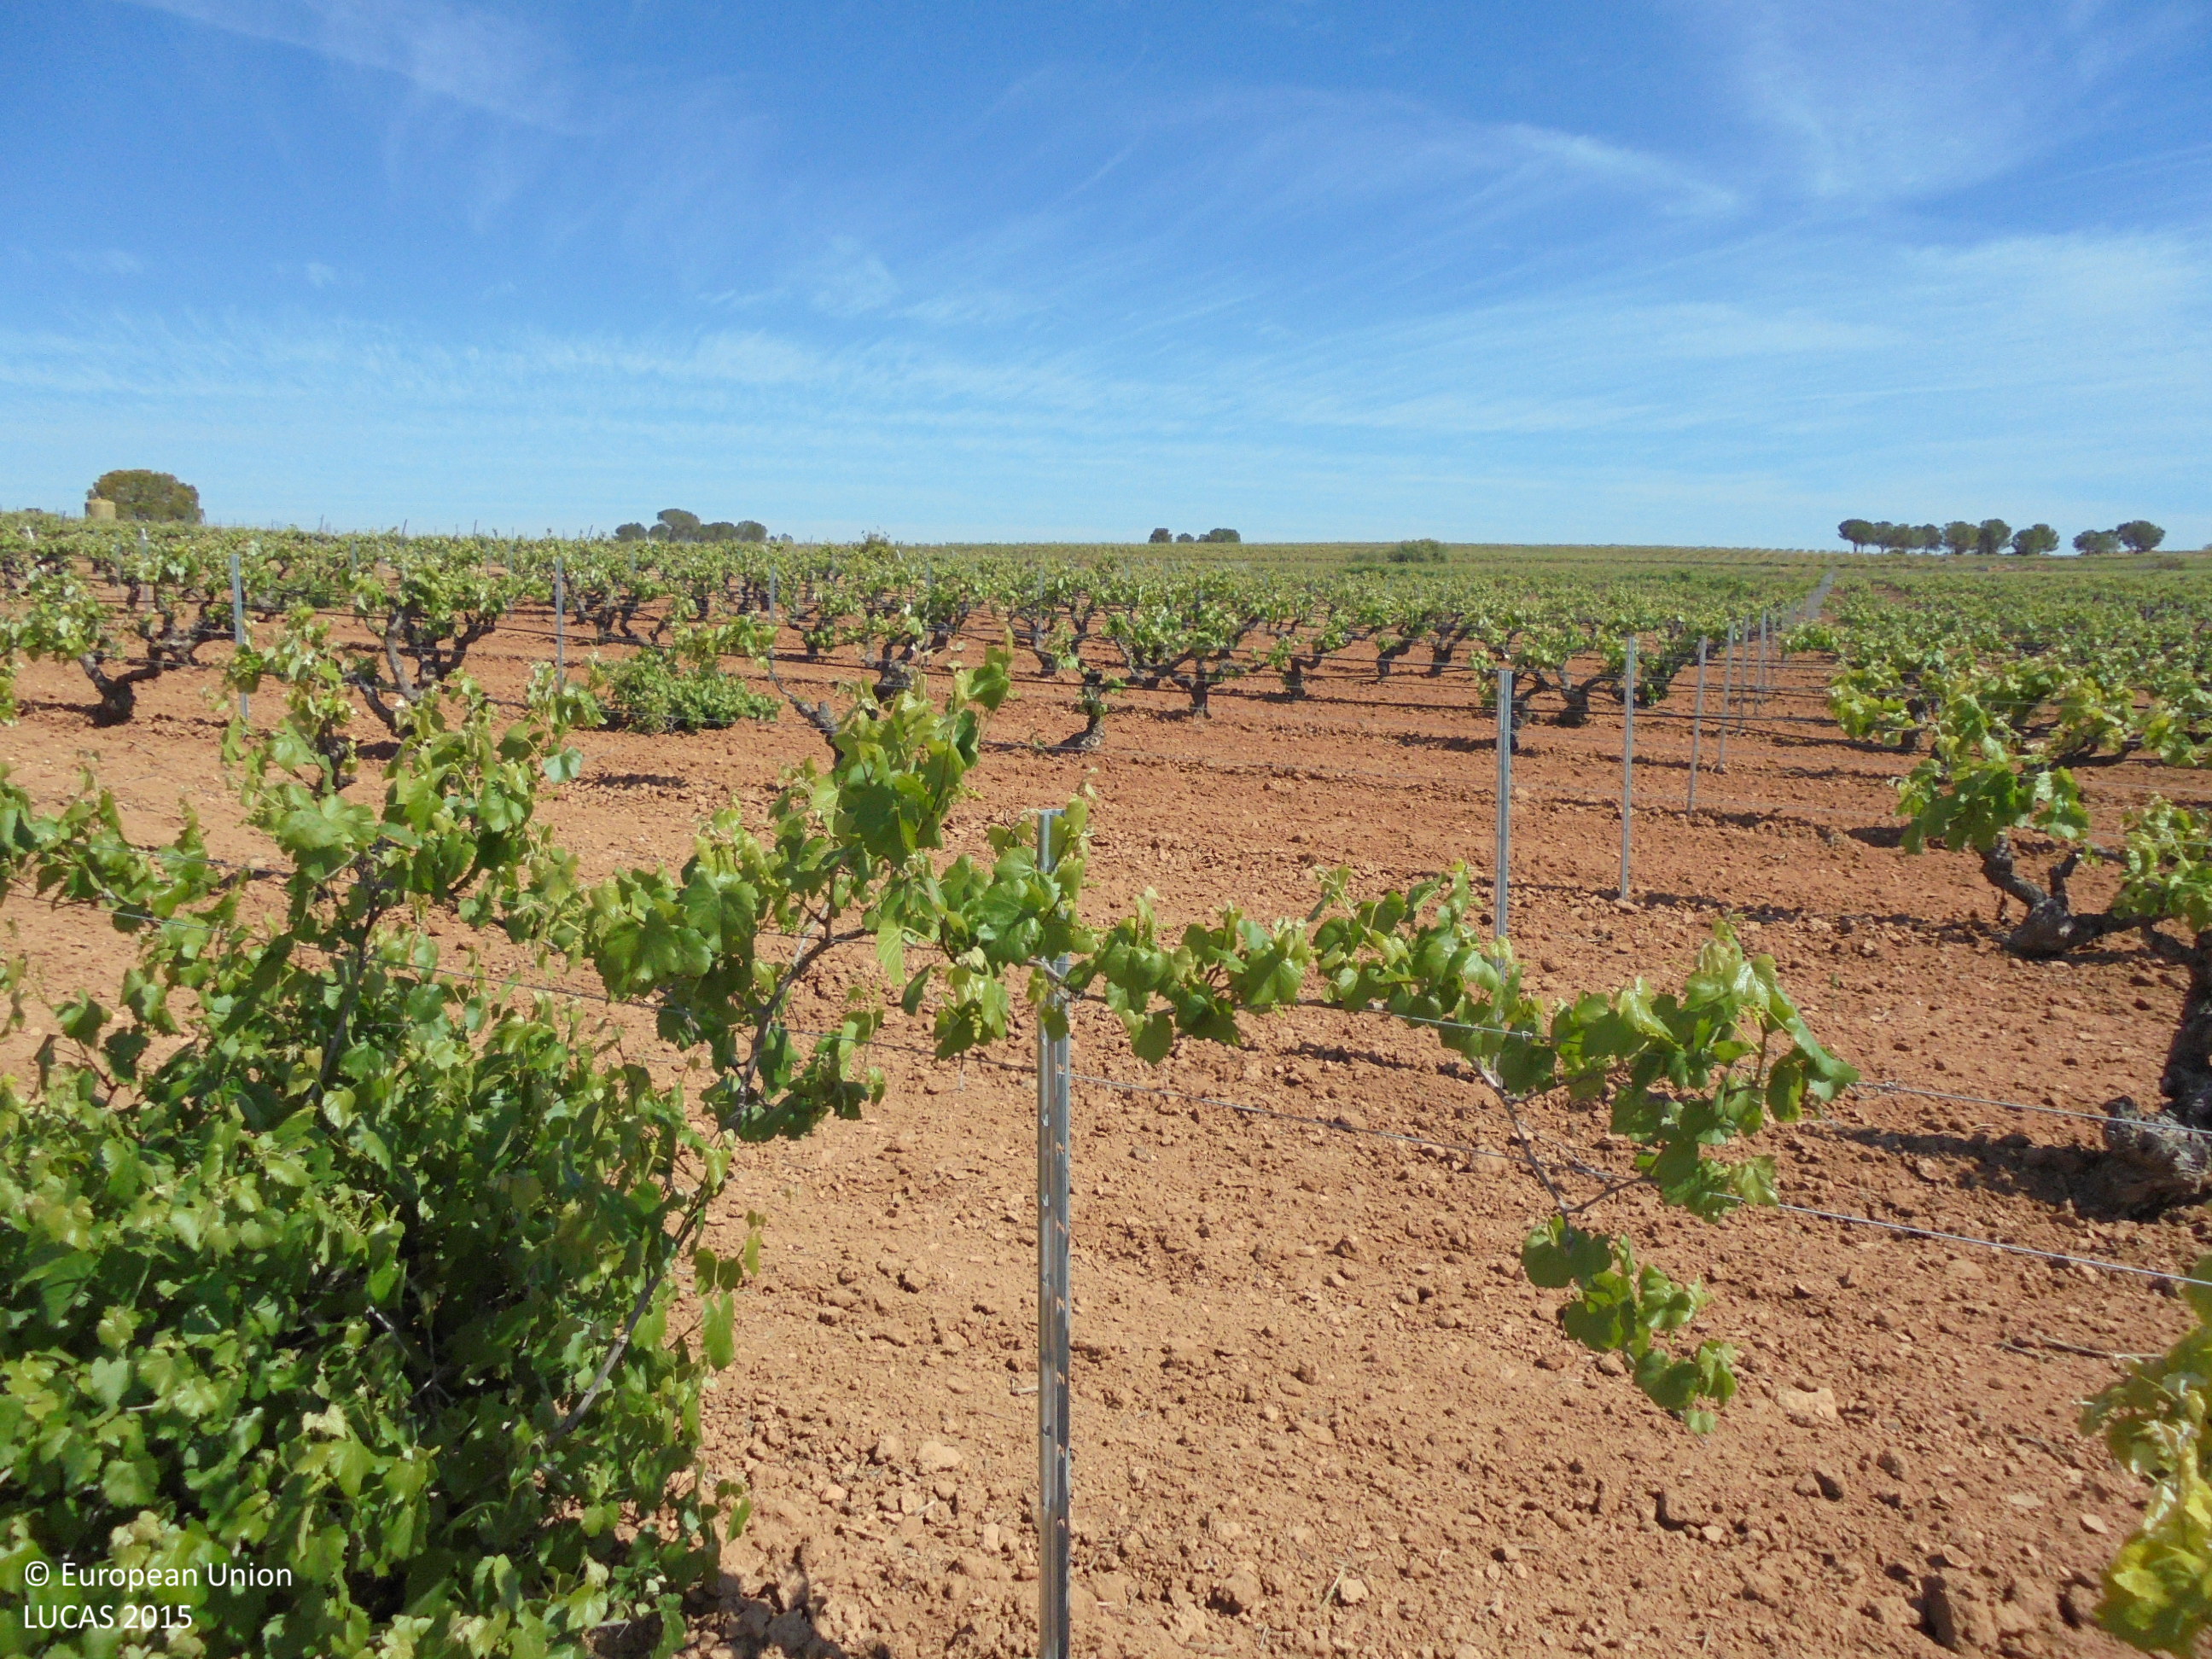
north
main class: Cropland
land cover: Vineyards
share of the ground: 10 - 25 %
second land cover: Other bare soil
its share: > 75 %
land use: Agriculture (excluding fallow land and kitchen gardens)
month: May
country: ES
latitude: 39.3071
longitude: -1.5644
